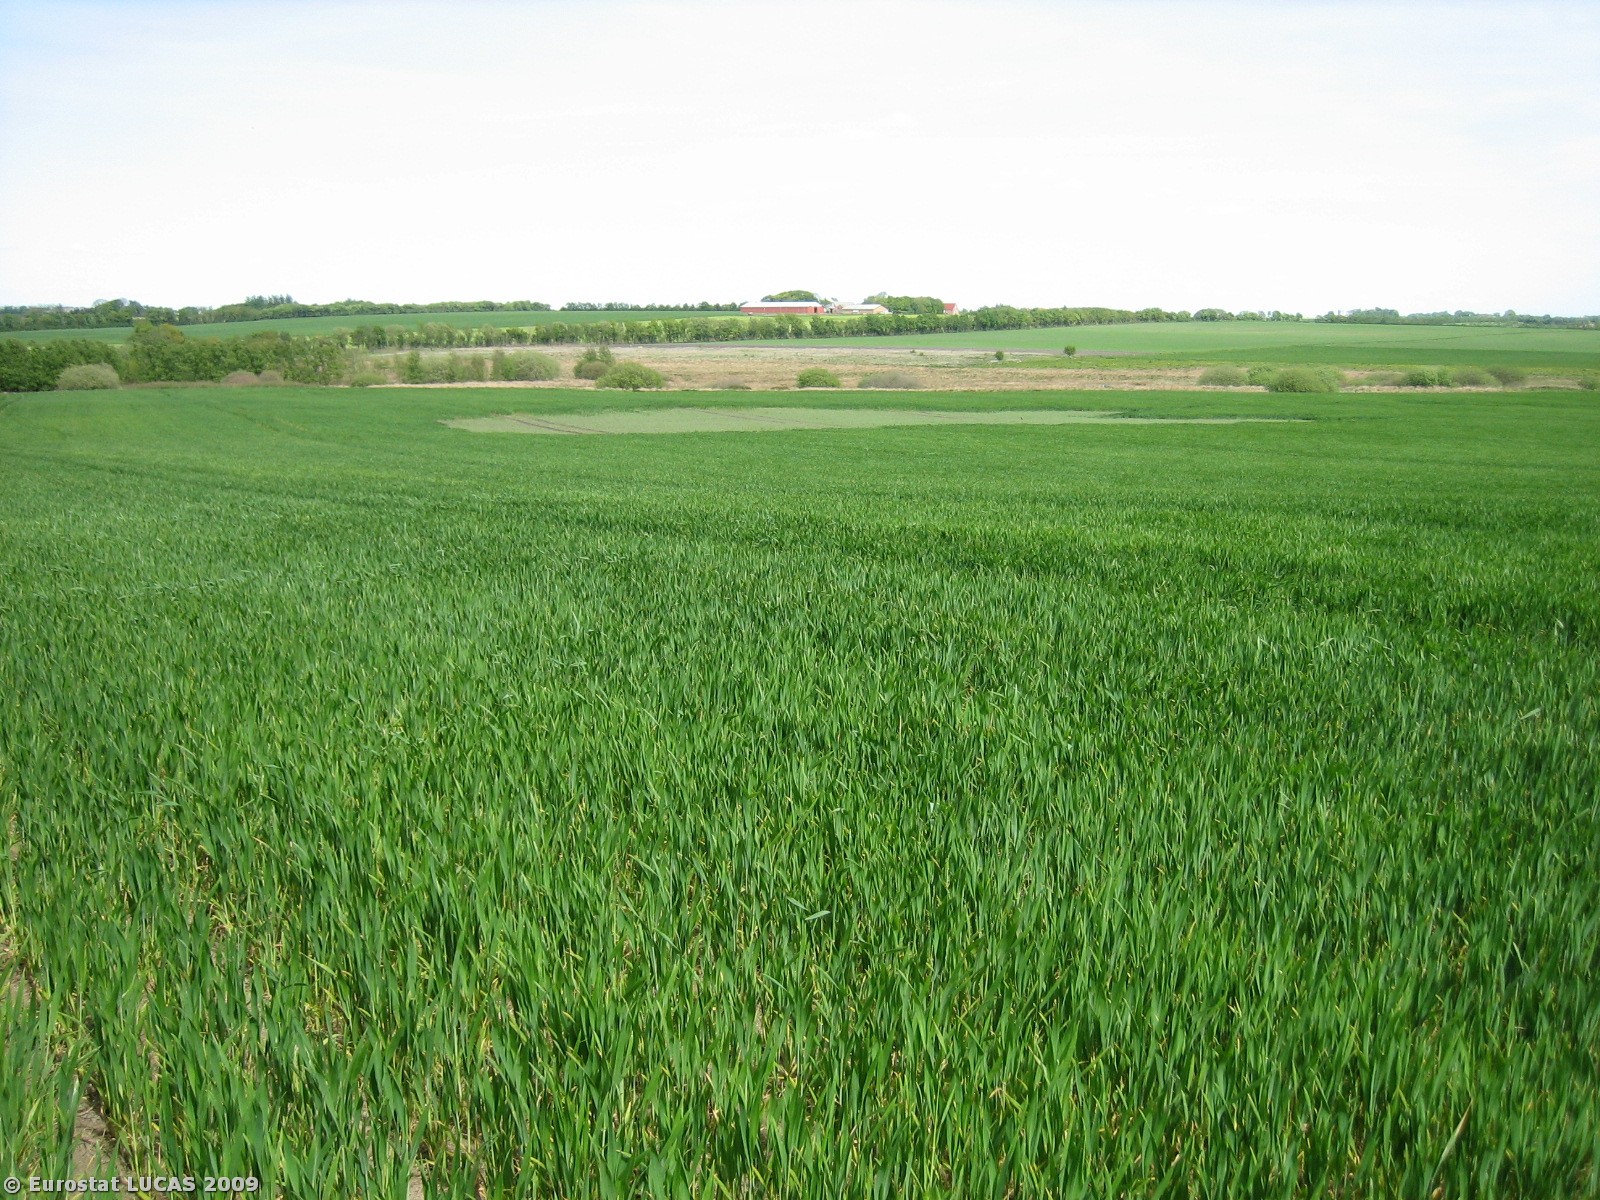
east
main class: Cropland
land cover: Barley
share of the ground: > 75 %
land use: Agriculture (excluding fallow land and kitchen gardens)
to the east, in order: Barley; Rye; Grassland without tree/shrub cover
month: May
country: DK
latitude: 55.9990
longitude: 8.4783
